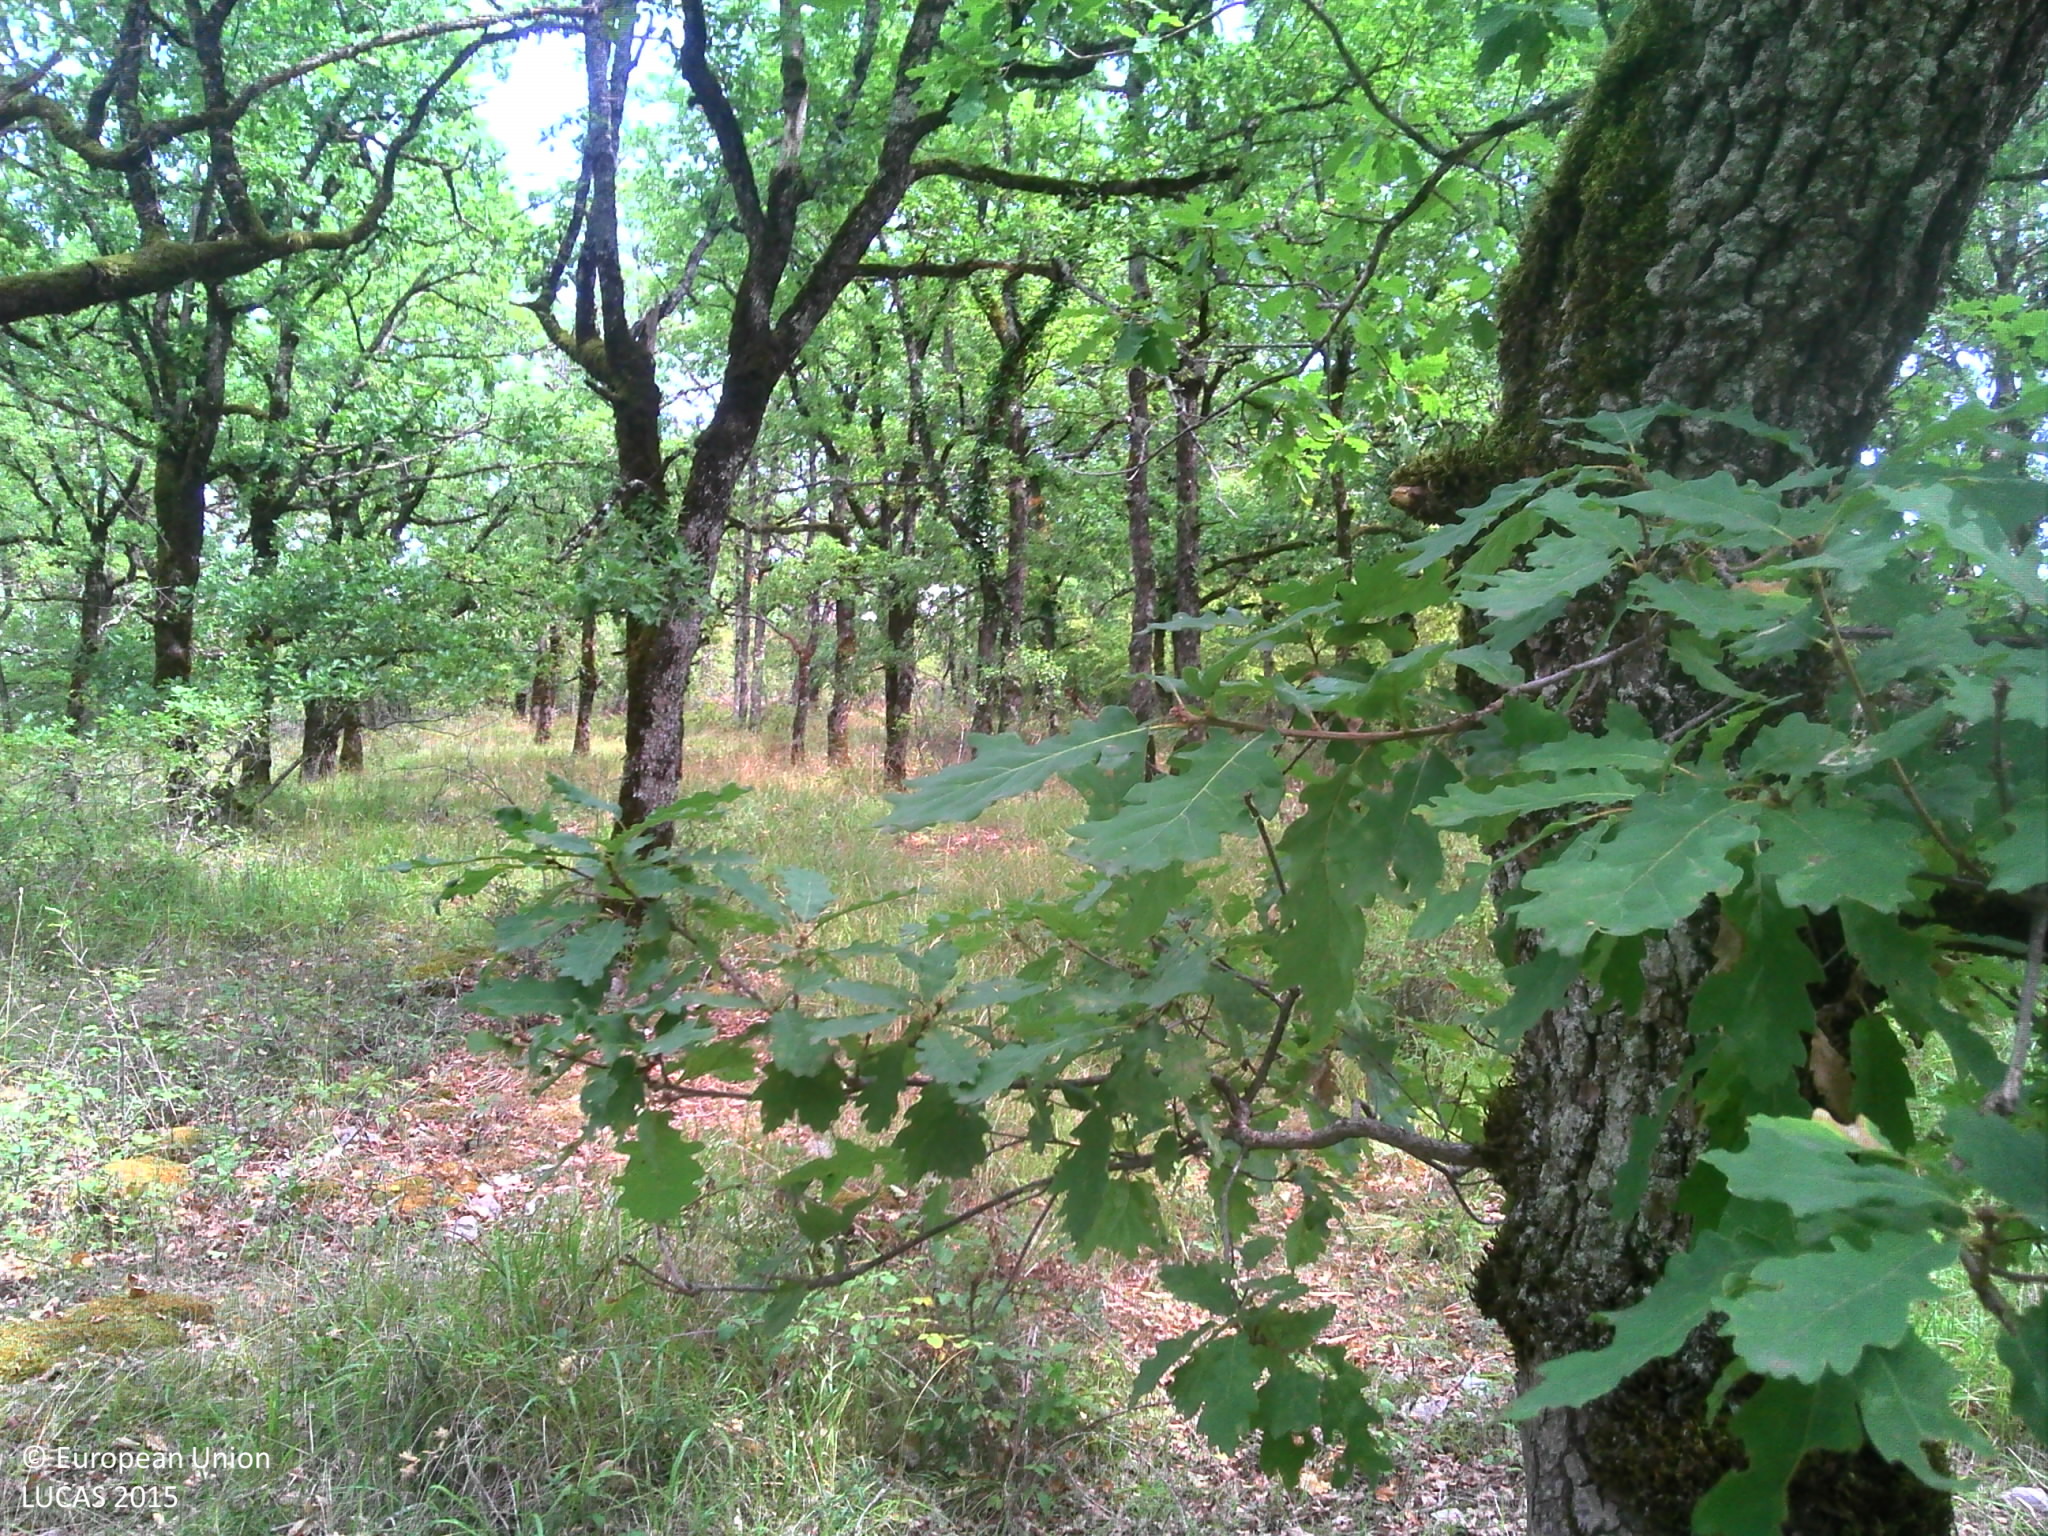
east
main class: Woodland
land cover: Broadleaved woodland
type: thermophilous deciduous forest
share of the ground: > 75 %
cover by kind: broadleaved forest trees 80 %, shrubs 10 %, herbaceous plants 10 %
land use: Forestry
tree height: > 5 m
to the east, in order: Broadleaved woodland; Fences; Broadleaved woodland; Dry stone walls; Broadleaved woodland; Grassland with sparse tree/shrub cover; Broadleaved woodland; Grassland with sparse tree/shrub cover; Dry stone walls; Shrubland with sparse tree cover; Fences; Shrubland with sparse tree cover; Grassland with sparse tree/shrub cover; Dry stone walls; Shrubland with sparse tree cover; Grassland with sparse tree/shrub cover; Dry stone walls; Grassland without tree/shrub cover
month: August
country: FR
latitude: 44.8579
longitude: 1.7851
